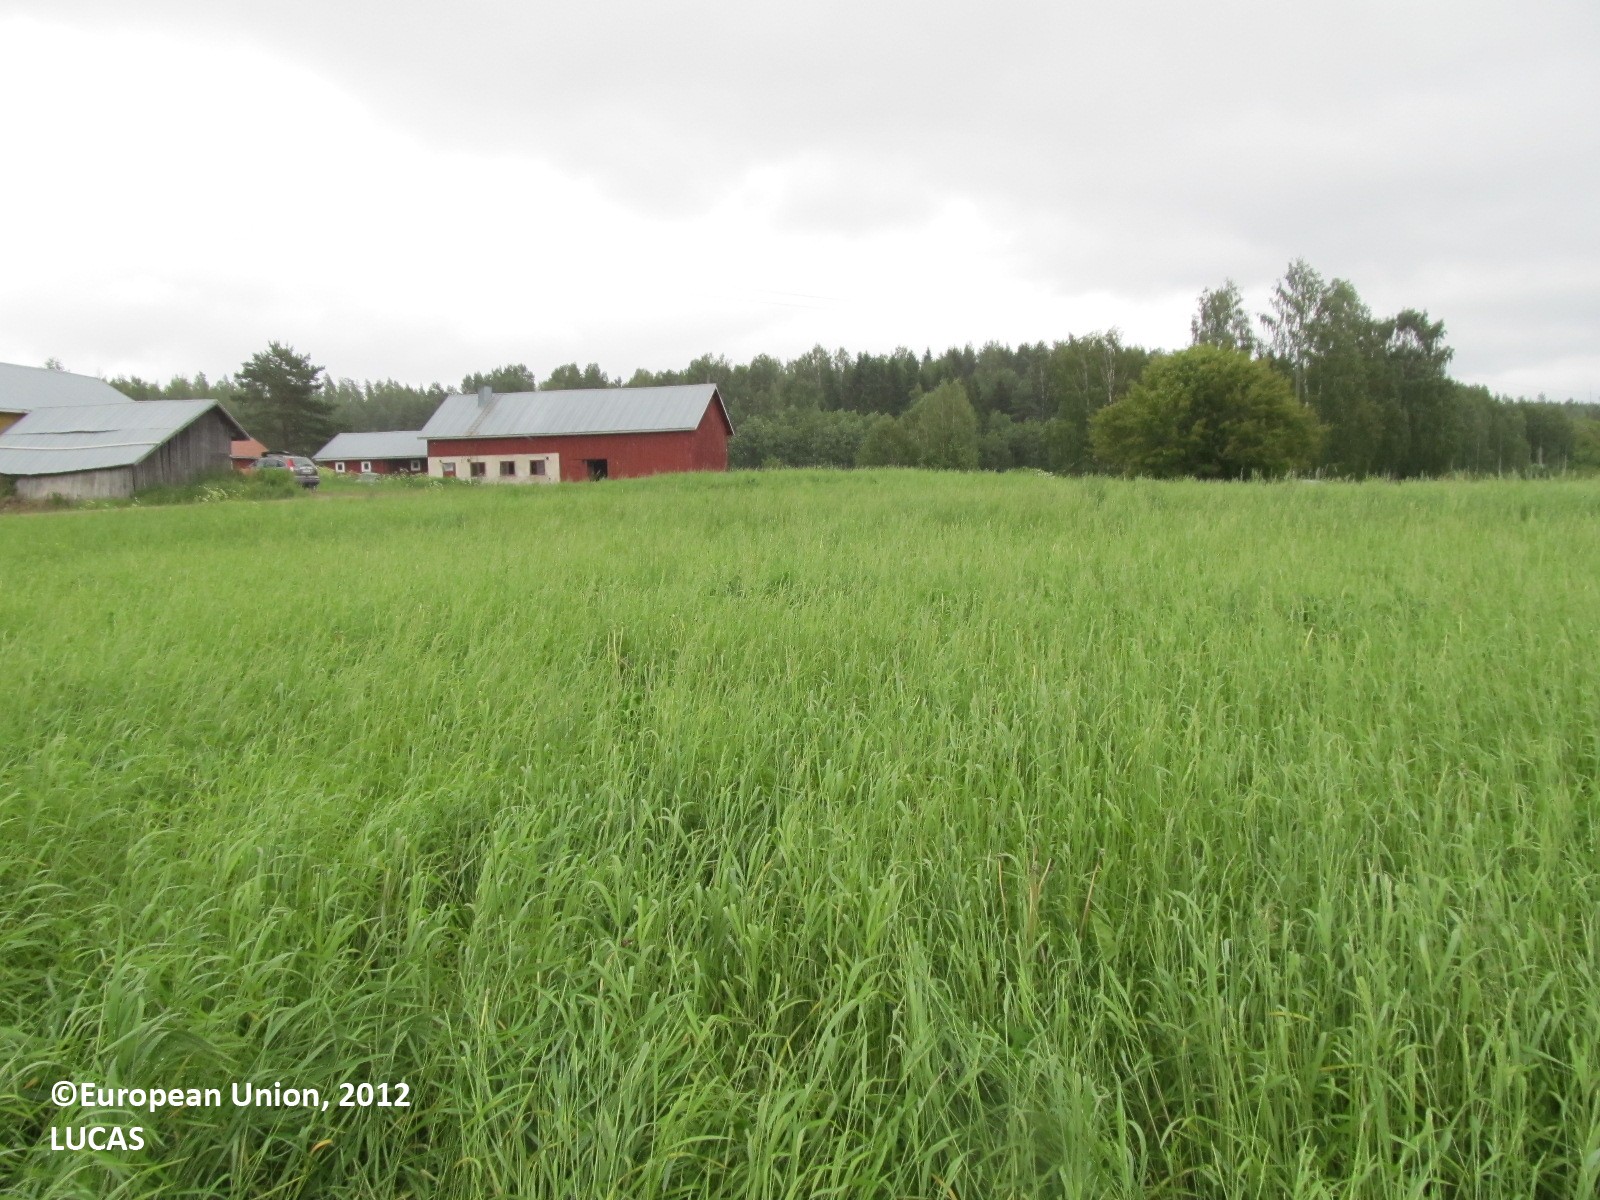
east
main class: Grassland
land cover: Grassland without tree/shrub cover
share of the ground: 50 - 75 %
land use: Fallow land
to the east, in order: Grassland without tree/shrub cover; Ditches and canals; Paved roads, cycling and walking lanes; Grass margins; Ditches and canals; Artificial constructions in urban areas; Ditches and canals; Grassland without tree/shrub cover; Broadleaved woodland
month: June
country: FI
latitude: 62.7713
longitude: 28.8006
